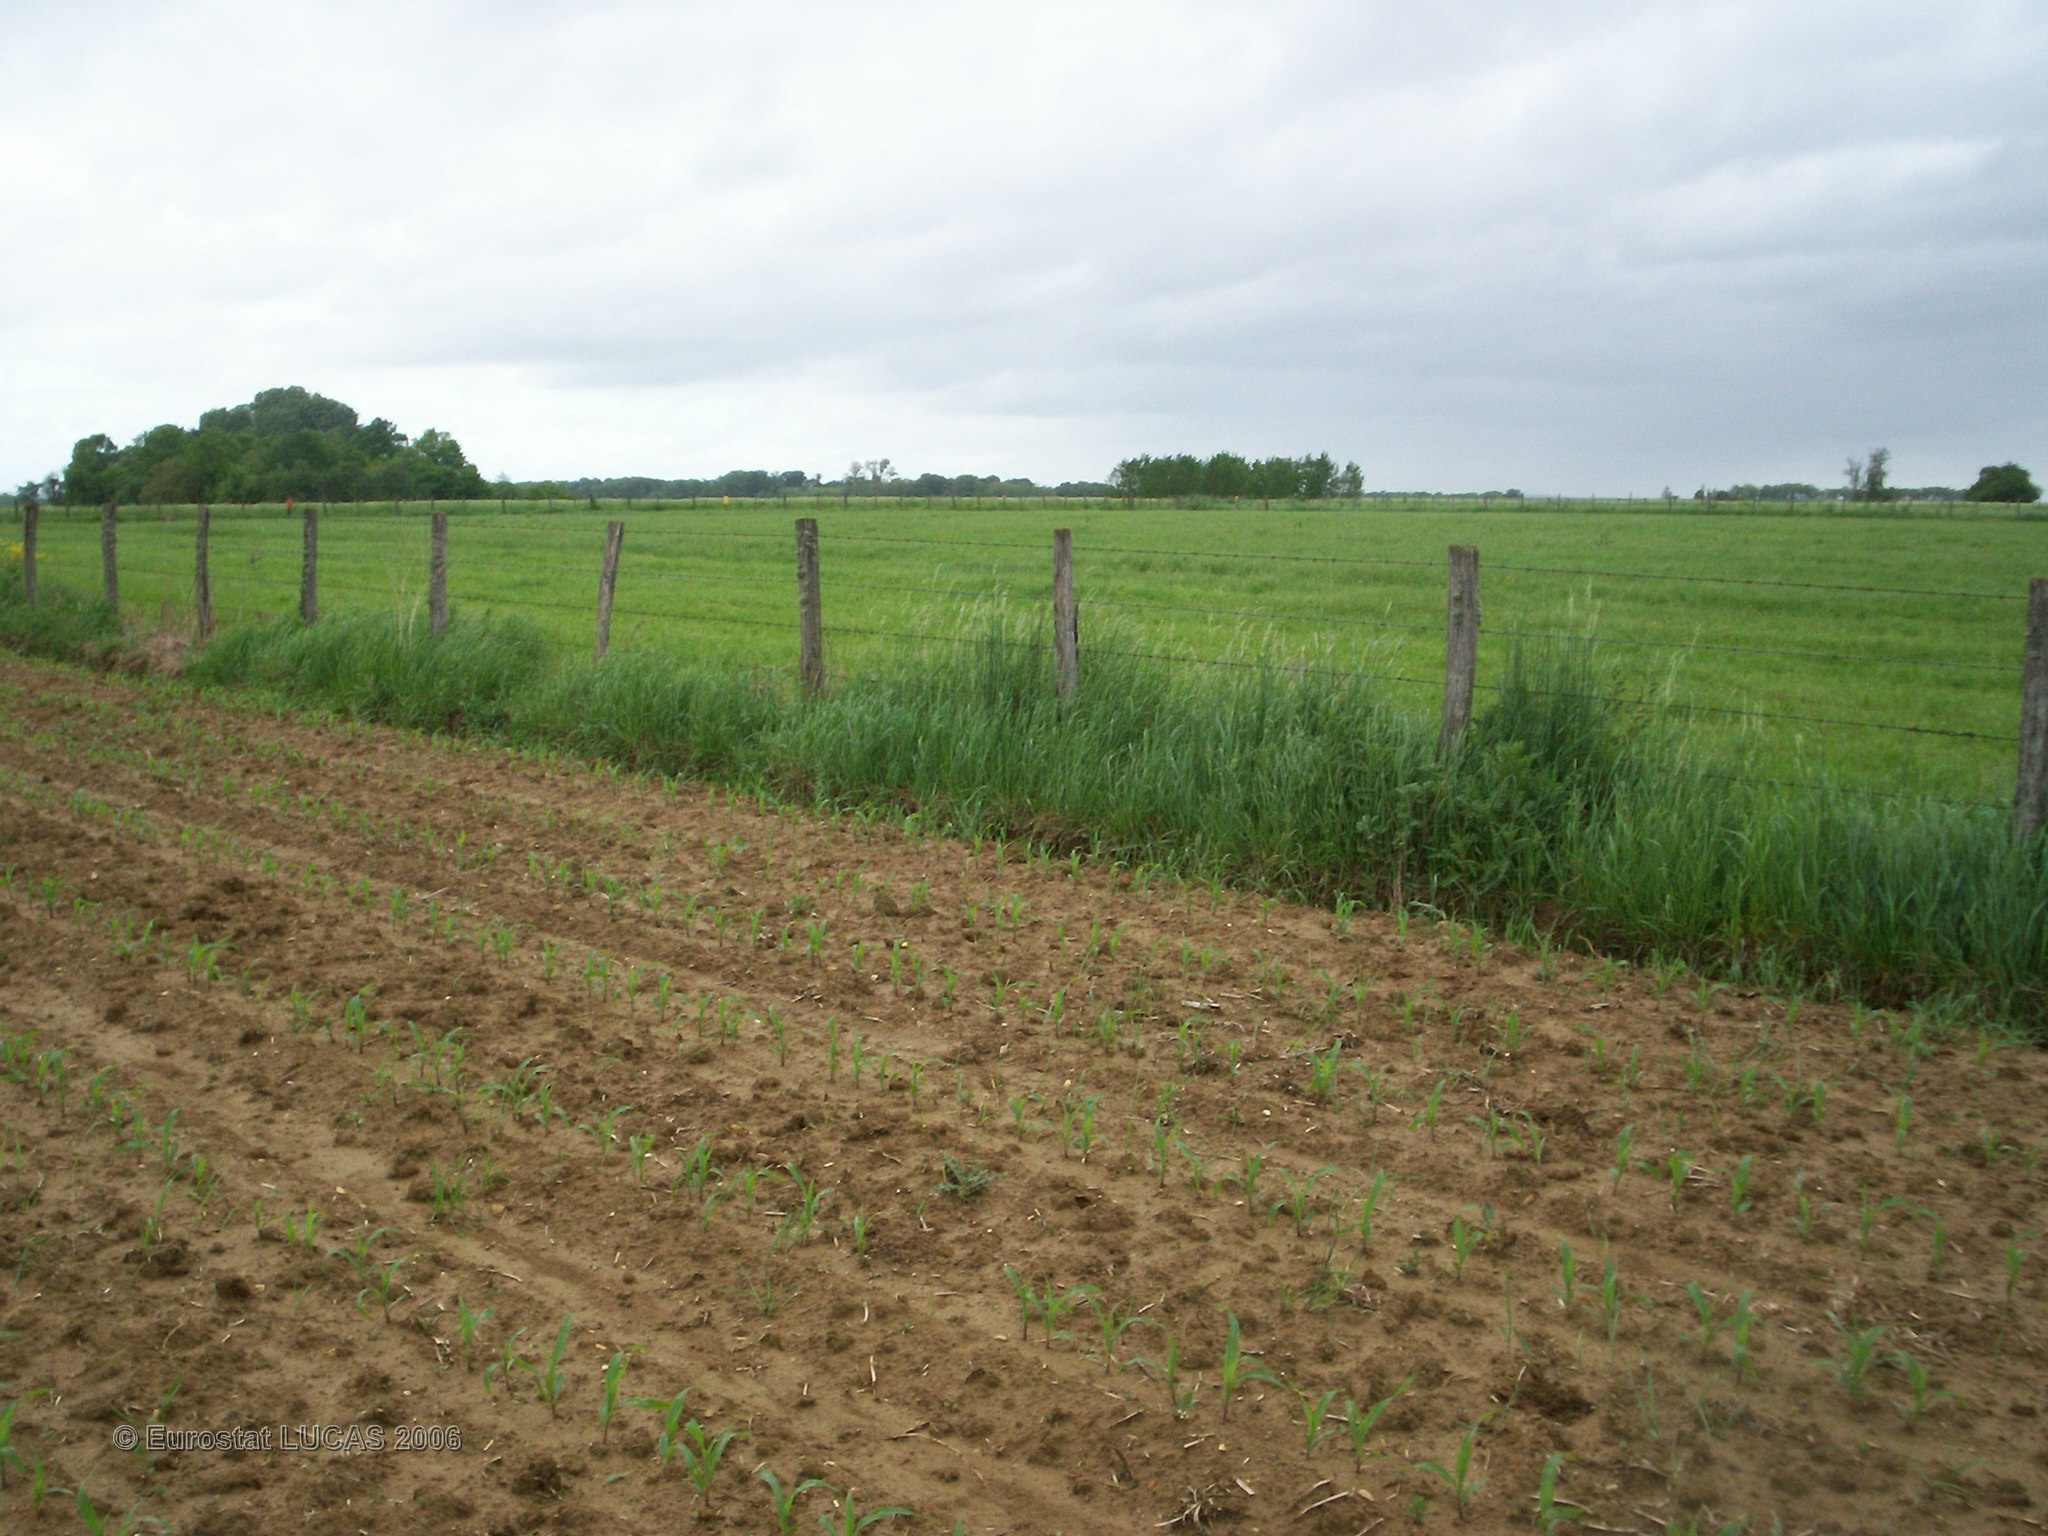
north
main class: Cropland
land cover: Maize
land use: Agriculture (excluding fallow land and kitchen gardens)
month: May
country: FR
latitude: 47.9780
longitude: 3.8202
